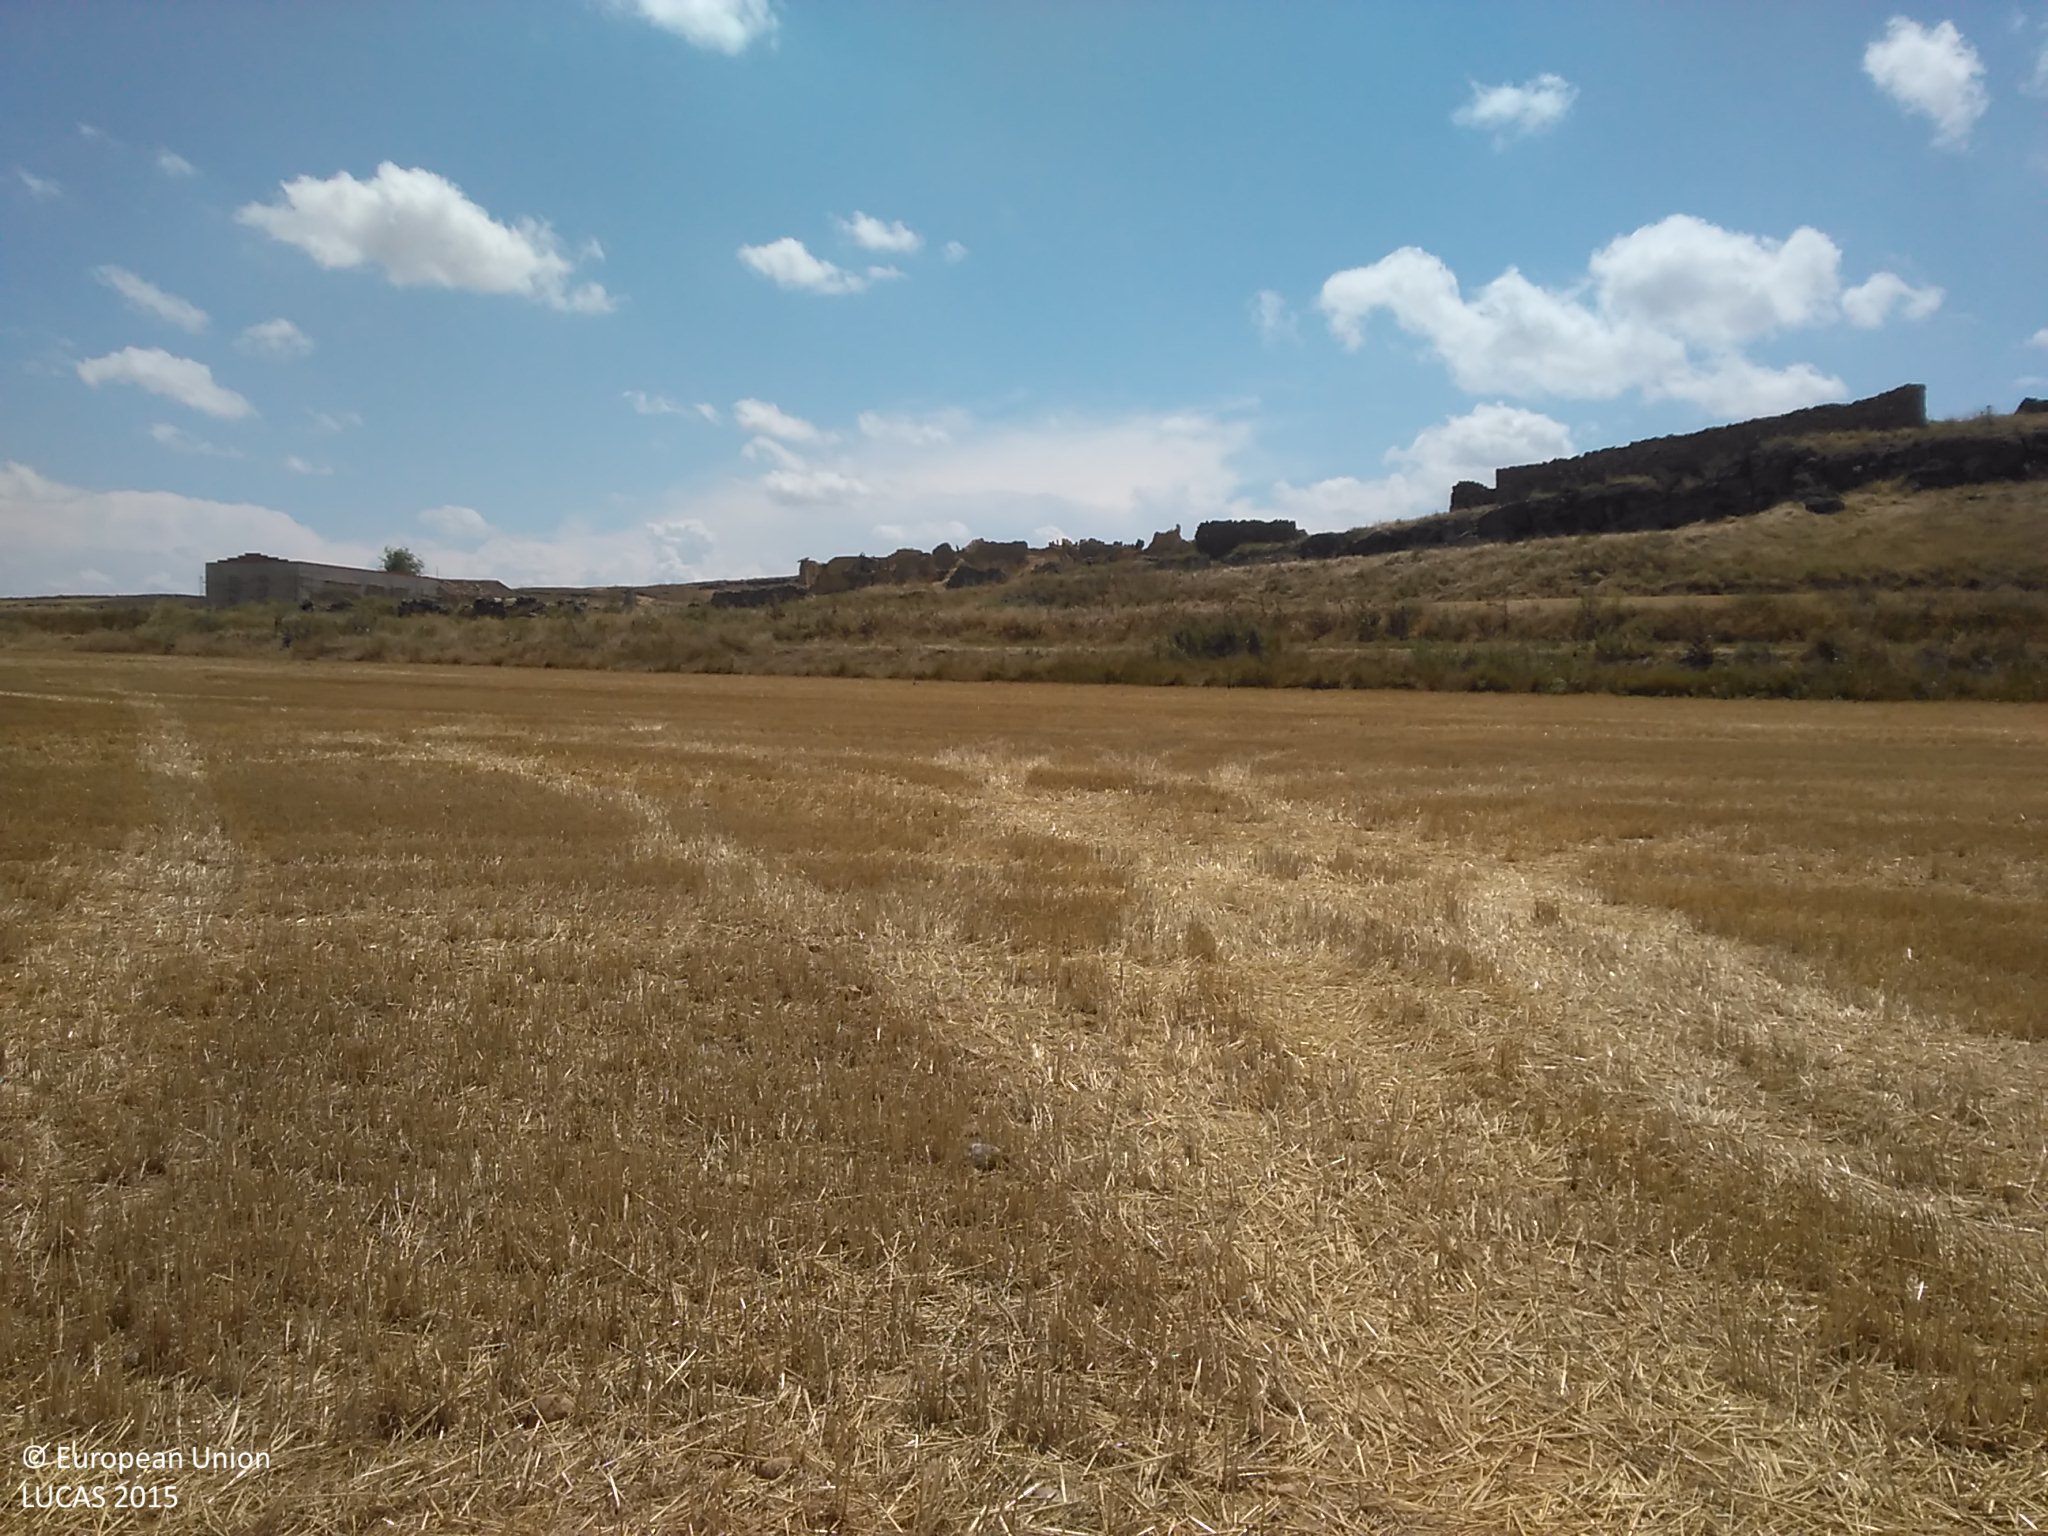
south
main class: Cropland
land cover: Common wheat
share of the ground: < 10 %
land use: Agriculture (excluding fallow land and kitchen gardens)
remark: Harvested field
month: July
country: ES
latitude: 41.6553
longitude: -2.2224
